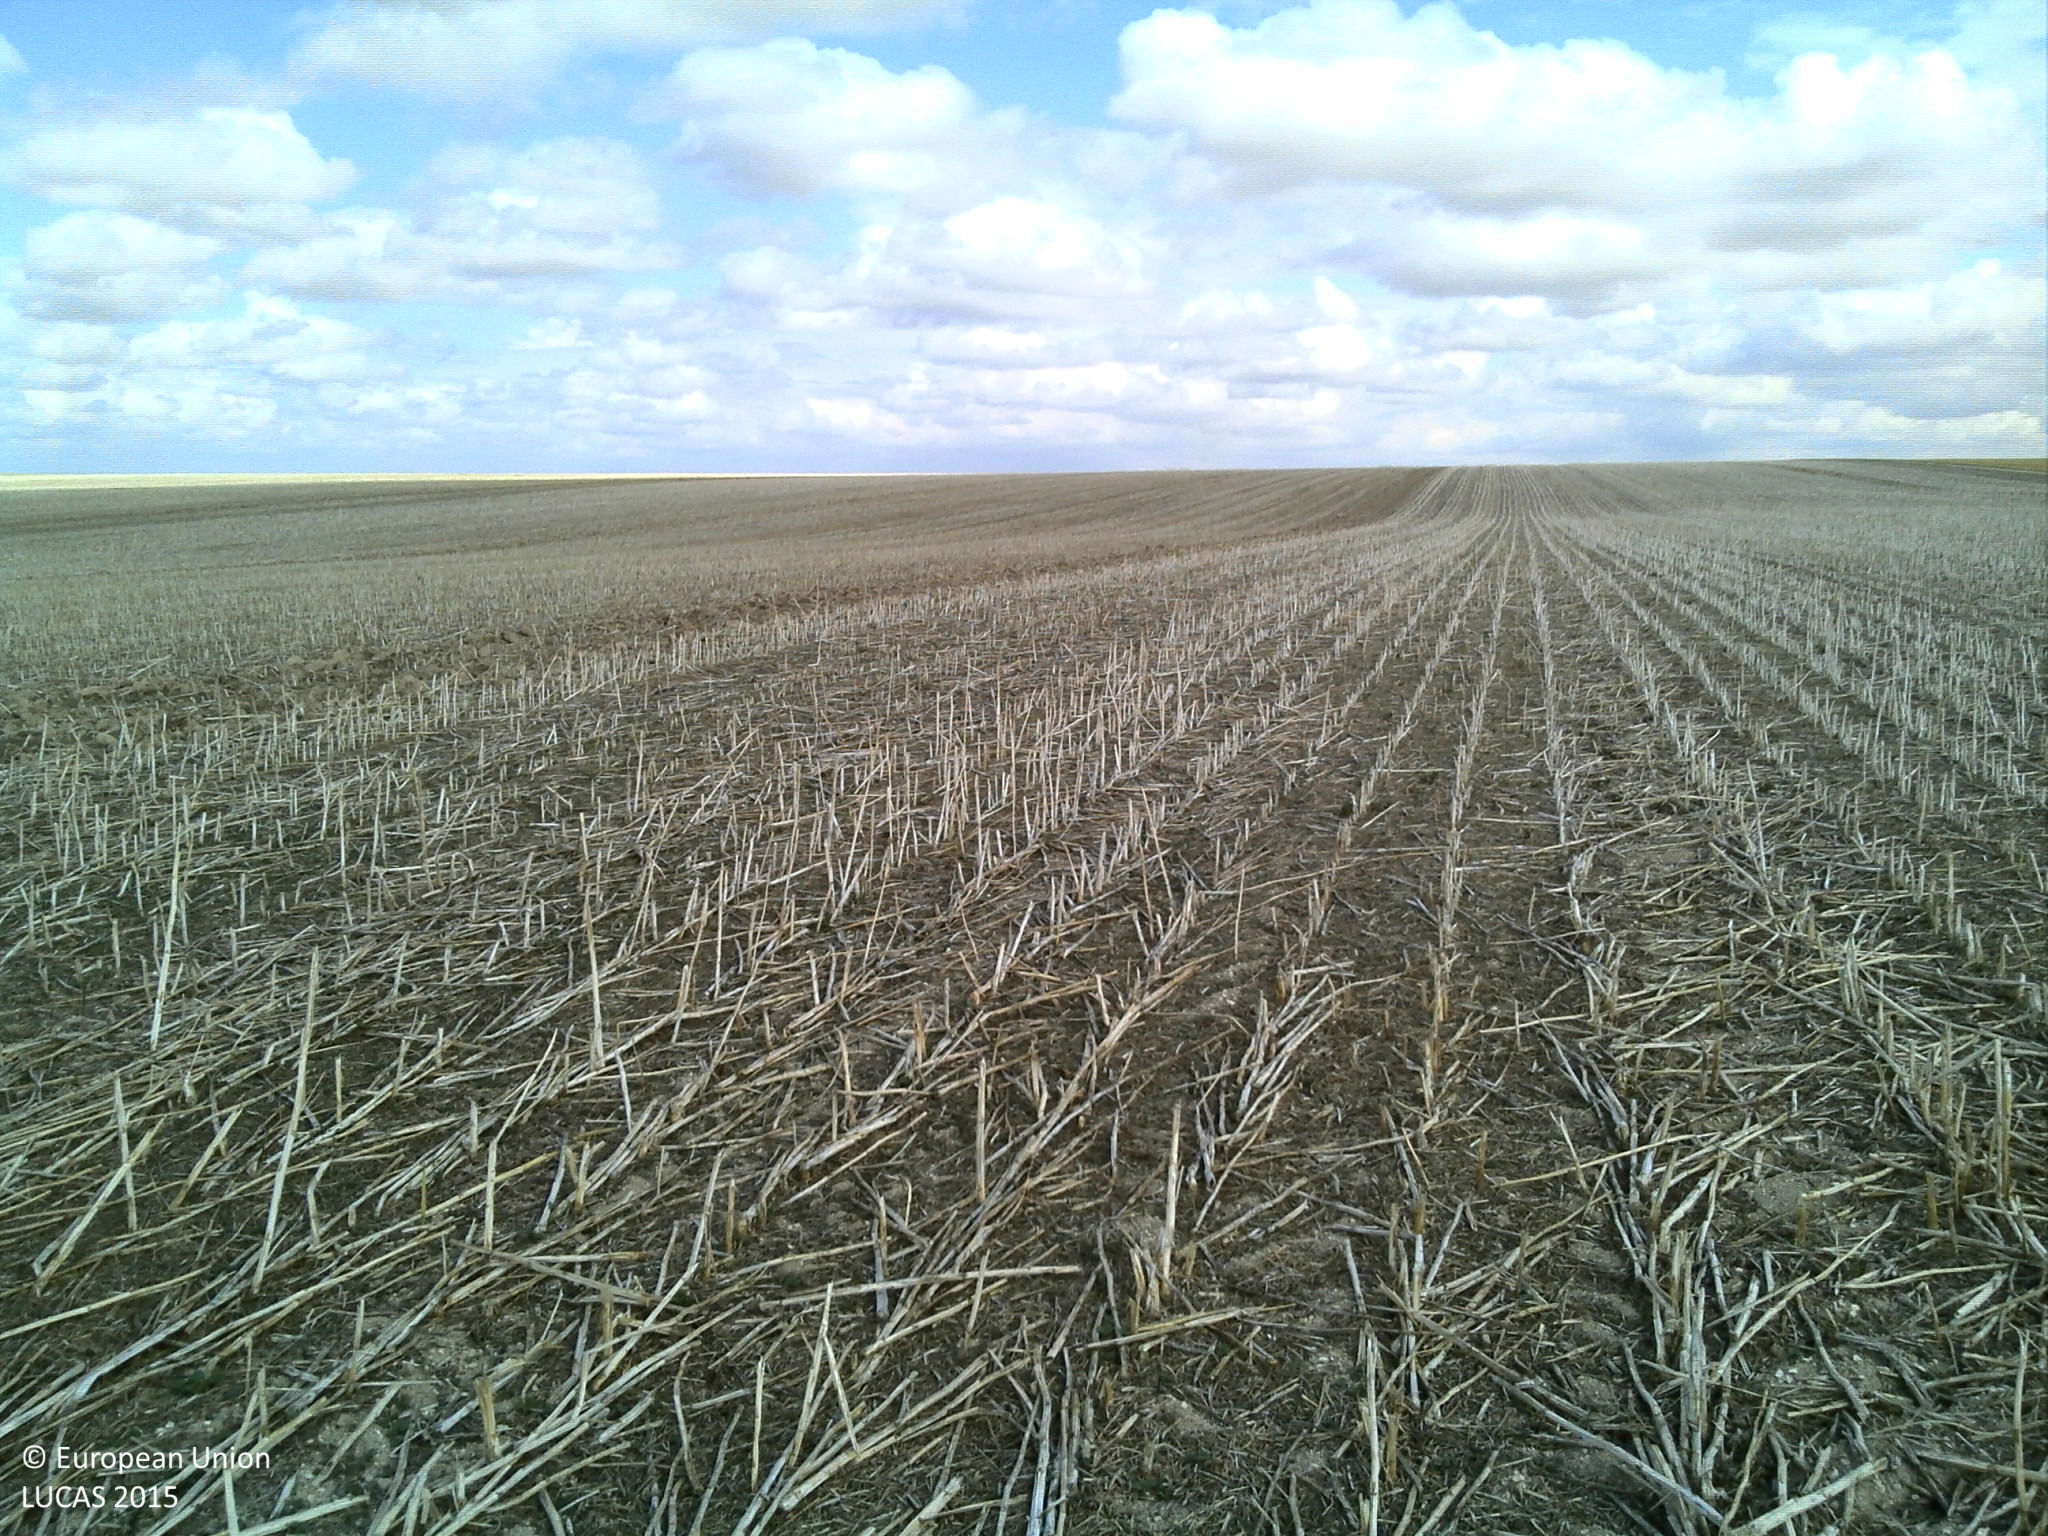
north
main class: Cropland
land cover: Rape and turnip rape
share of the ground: > 75 %
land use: Agriculture (excluding fallow land and kitchen gardens)
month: August
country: FR
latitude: 48.7406
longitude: 4.2441
